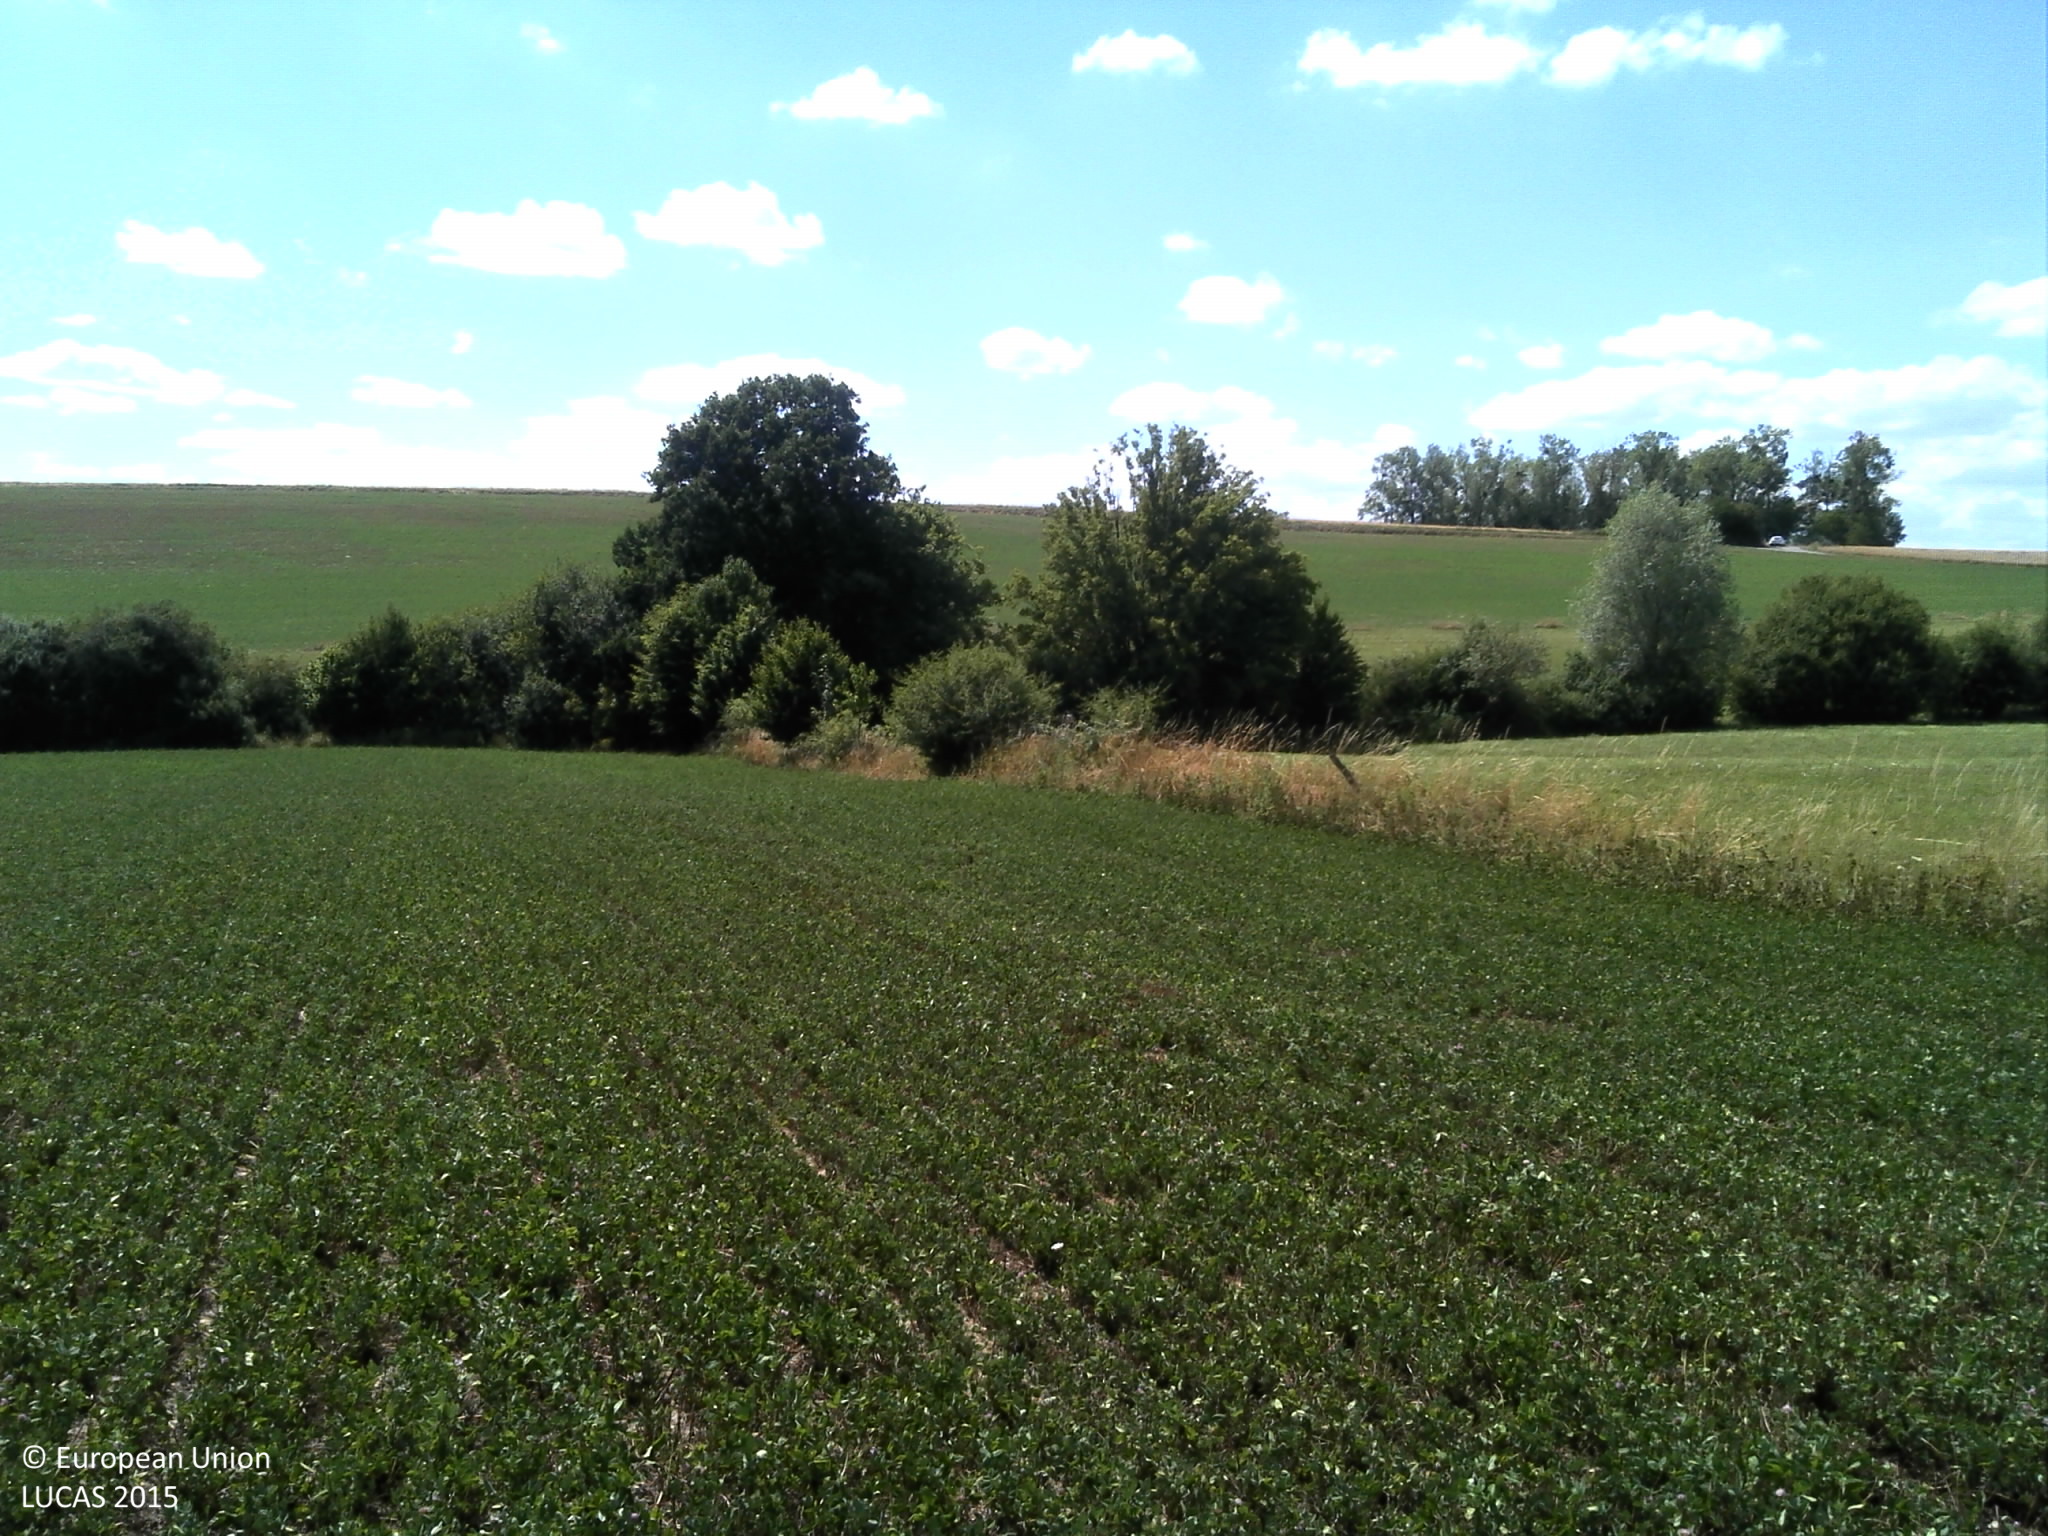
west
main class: Cropland
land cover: Clovers
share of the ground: > 75 %
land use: Agriculture (excluding fallow land and kitchen gardens)
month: July
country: FR
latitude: 48.9995
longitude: 7.2531
